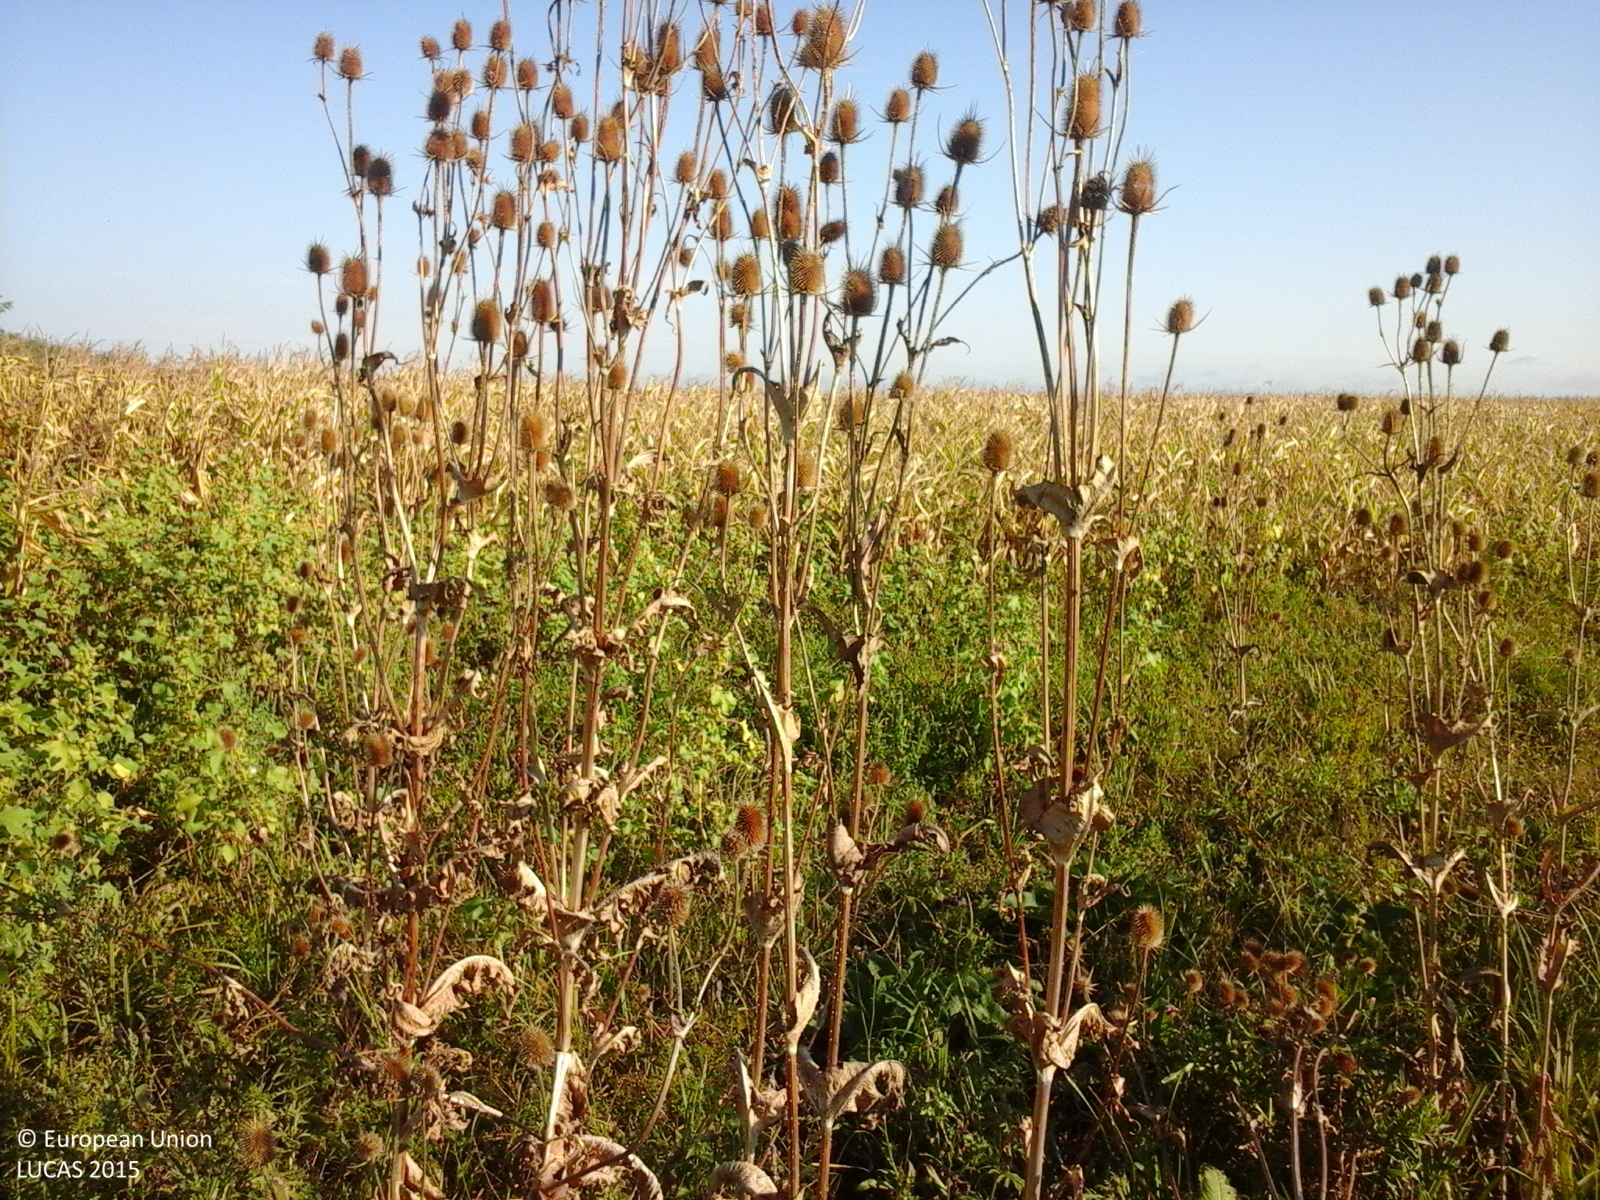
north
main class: Grassland
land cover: Spontaneously vegetated surfaces
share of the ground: > 75 %
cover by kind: herbaceous plants 100 %
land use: Fallow land
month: September
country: RO
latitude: 47.5607
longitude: 22.8348
